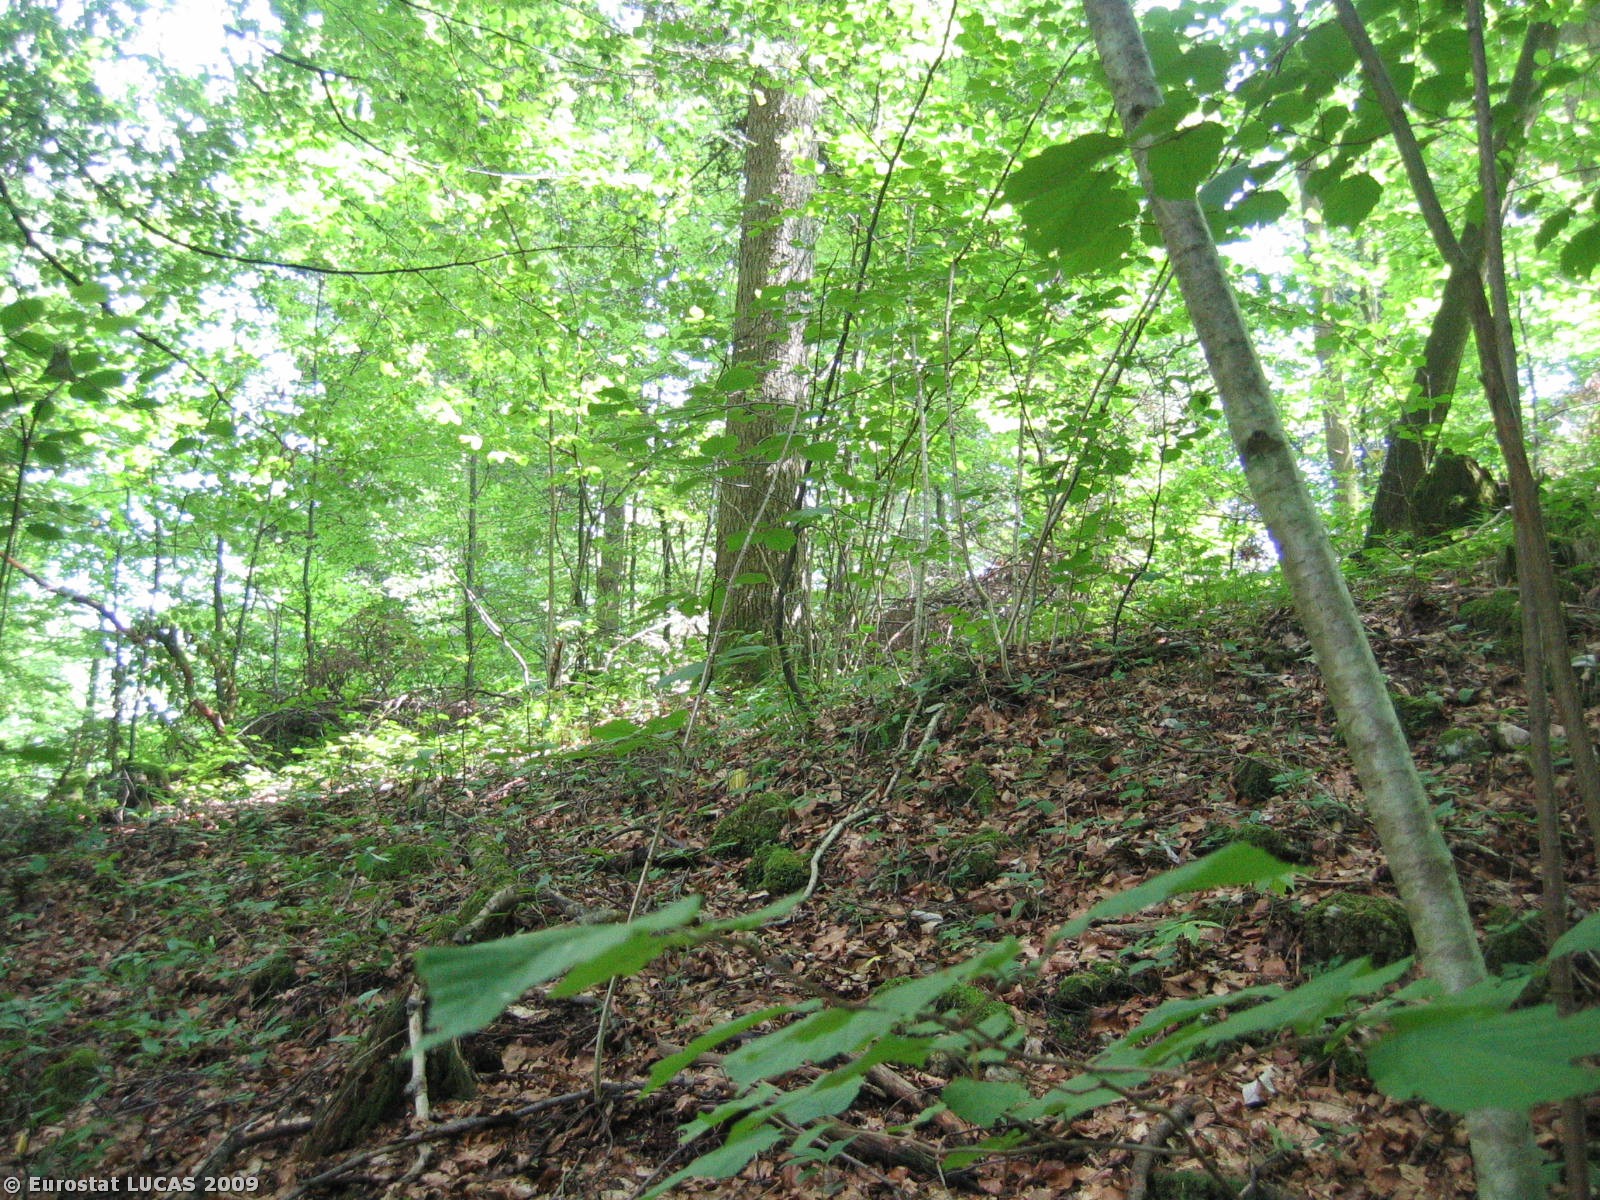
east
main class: Woodland
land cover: Mixed woodland
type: mountainous beech forest
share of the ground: > 75 %
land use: Forestry
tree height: > 5 m
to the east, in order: Mixed woodland; Shrubland with sparse tree cover; Mixed woodland; Ditches and canals; Mixed woodland; Tracks; Mixed woodland; Tracks; Mixed woodland
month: August
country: SI
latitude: 45.8844
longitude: 14.3385
